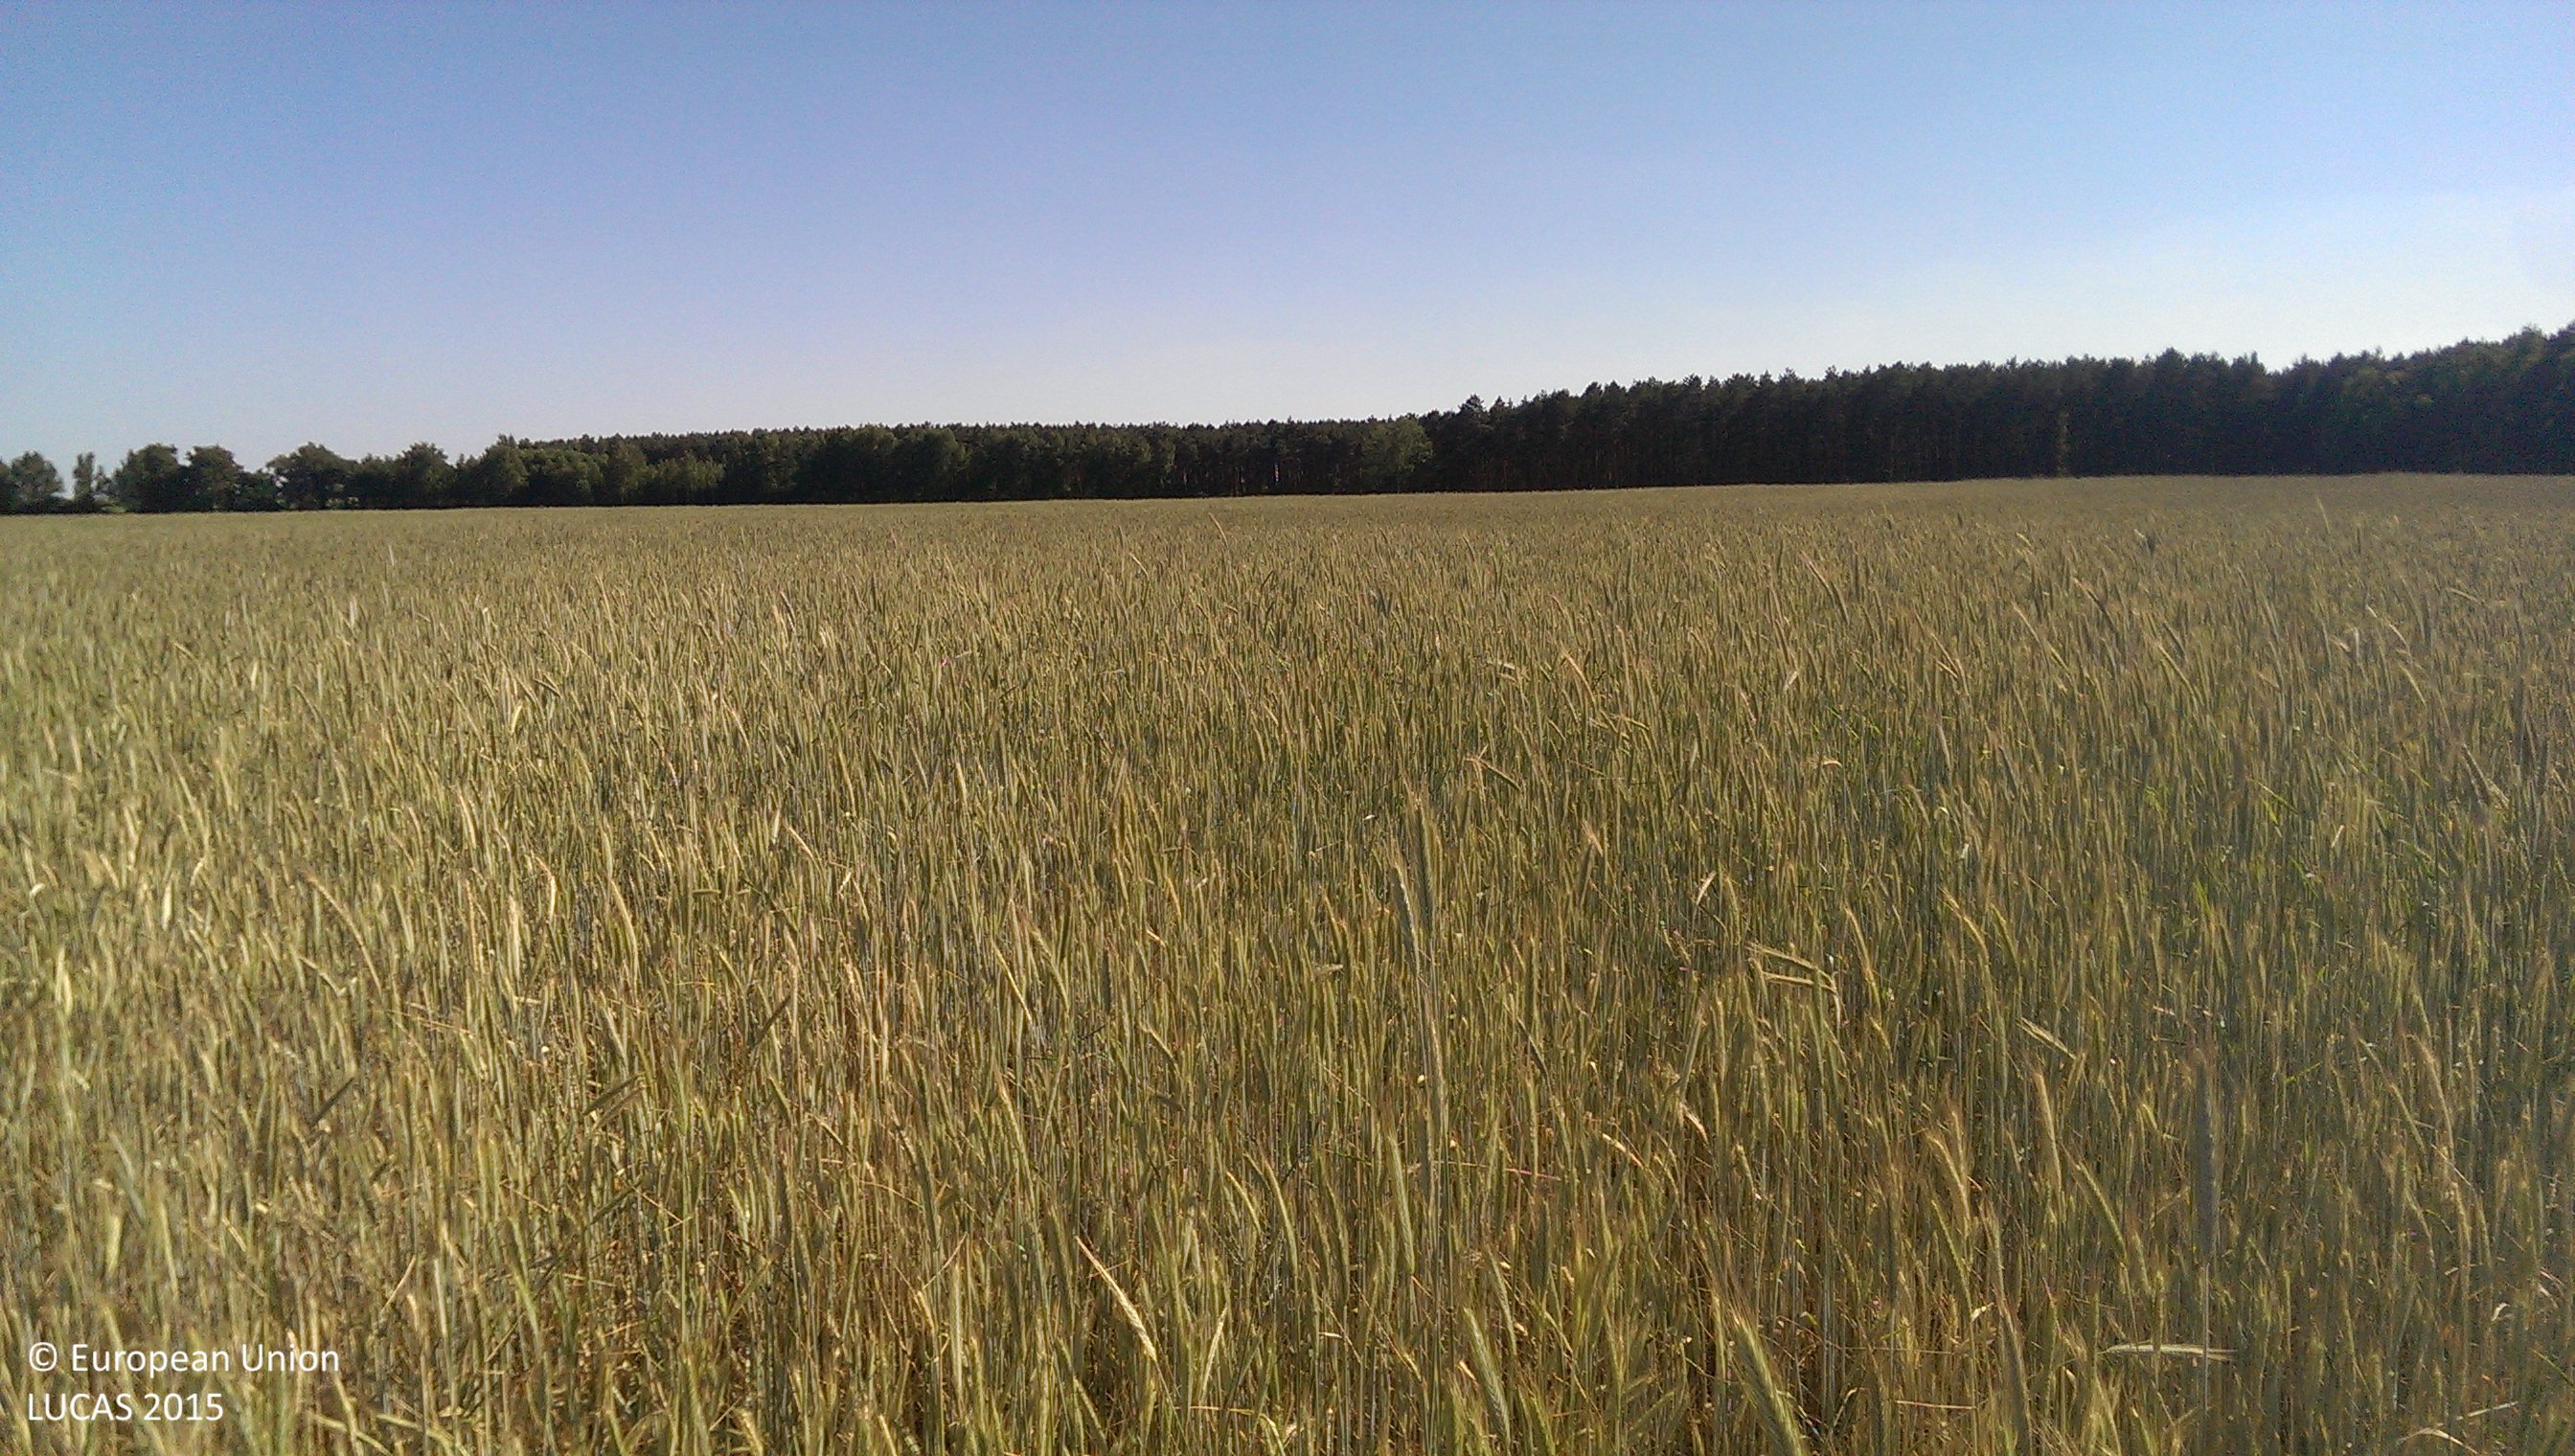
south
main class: Cropland
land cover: Rye
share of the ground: > 75 %
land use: Agriculture (excluding fallow land and kitchen gardens)
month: June
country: PL
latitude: 51.7650
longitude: 16.1937
